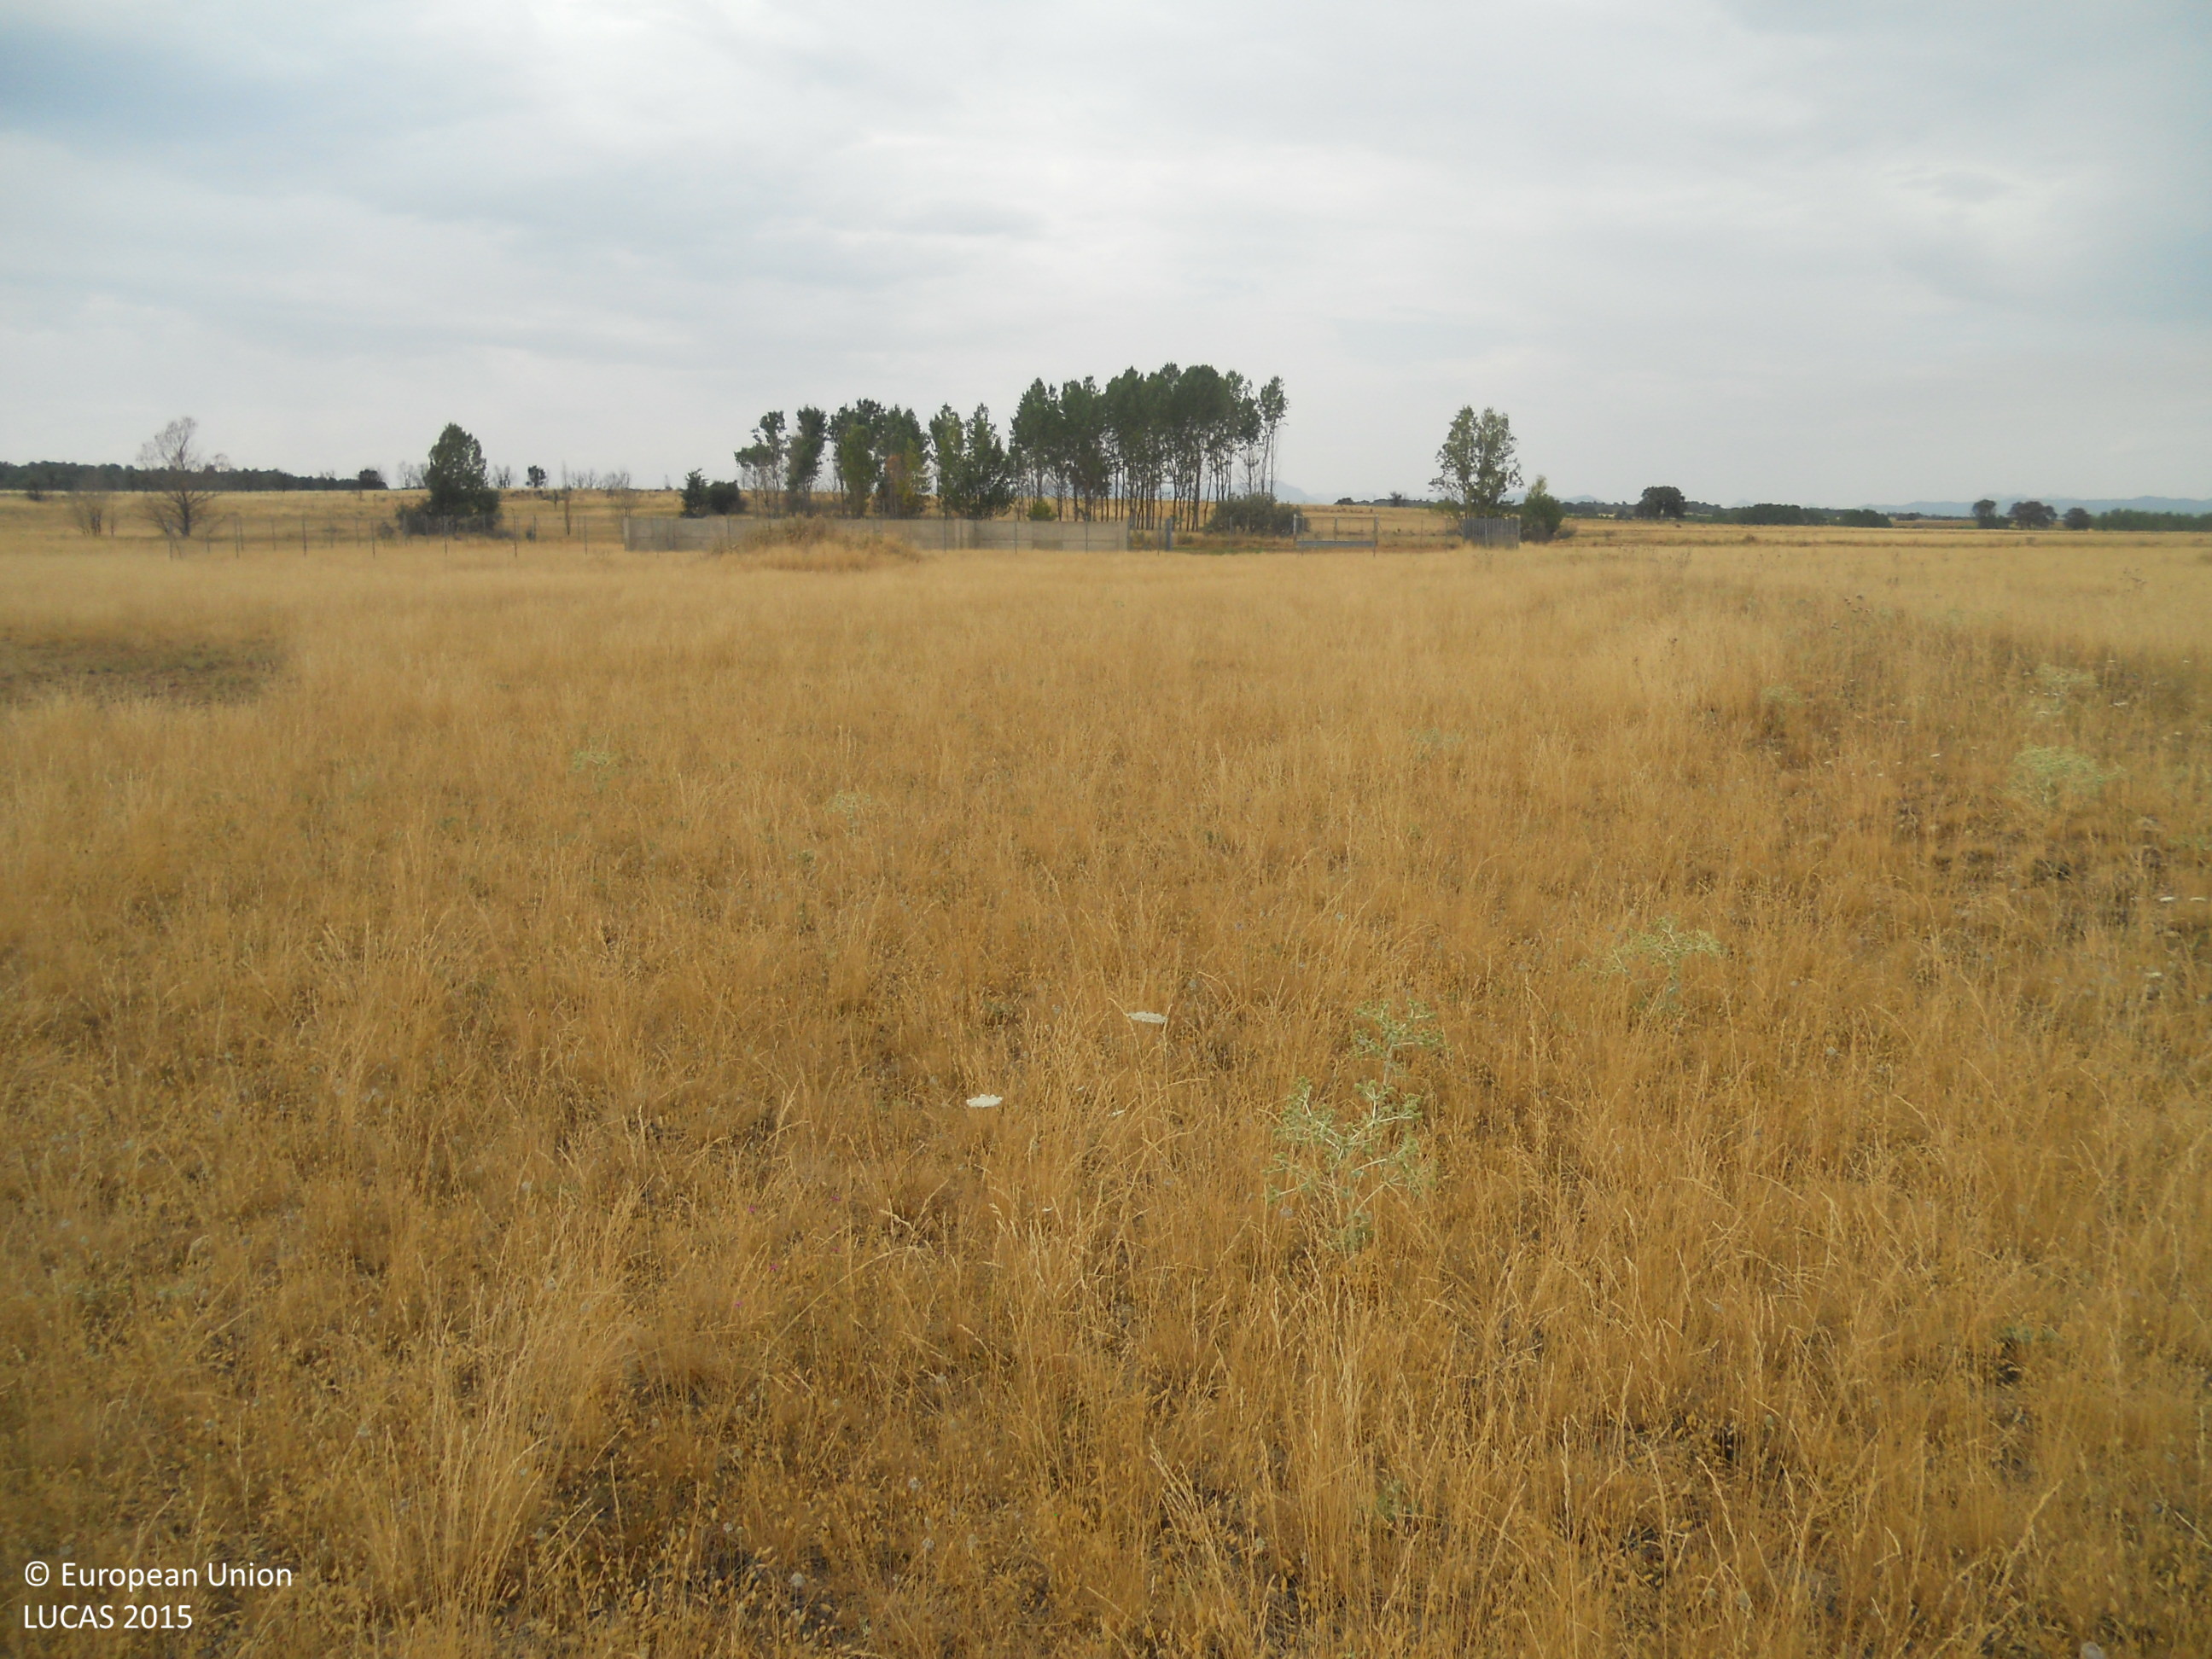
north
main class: Grassland
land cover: Spontaneously vegetated surfaces
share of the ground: > 75 %
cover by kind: herbaceous plants 100 %
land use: Fallow land
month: July
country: ES
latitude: 42.6211
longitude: -5.4197
